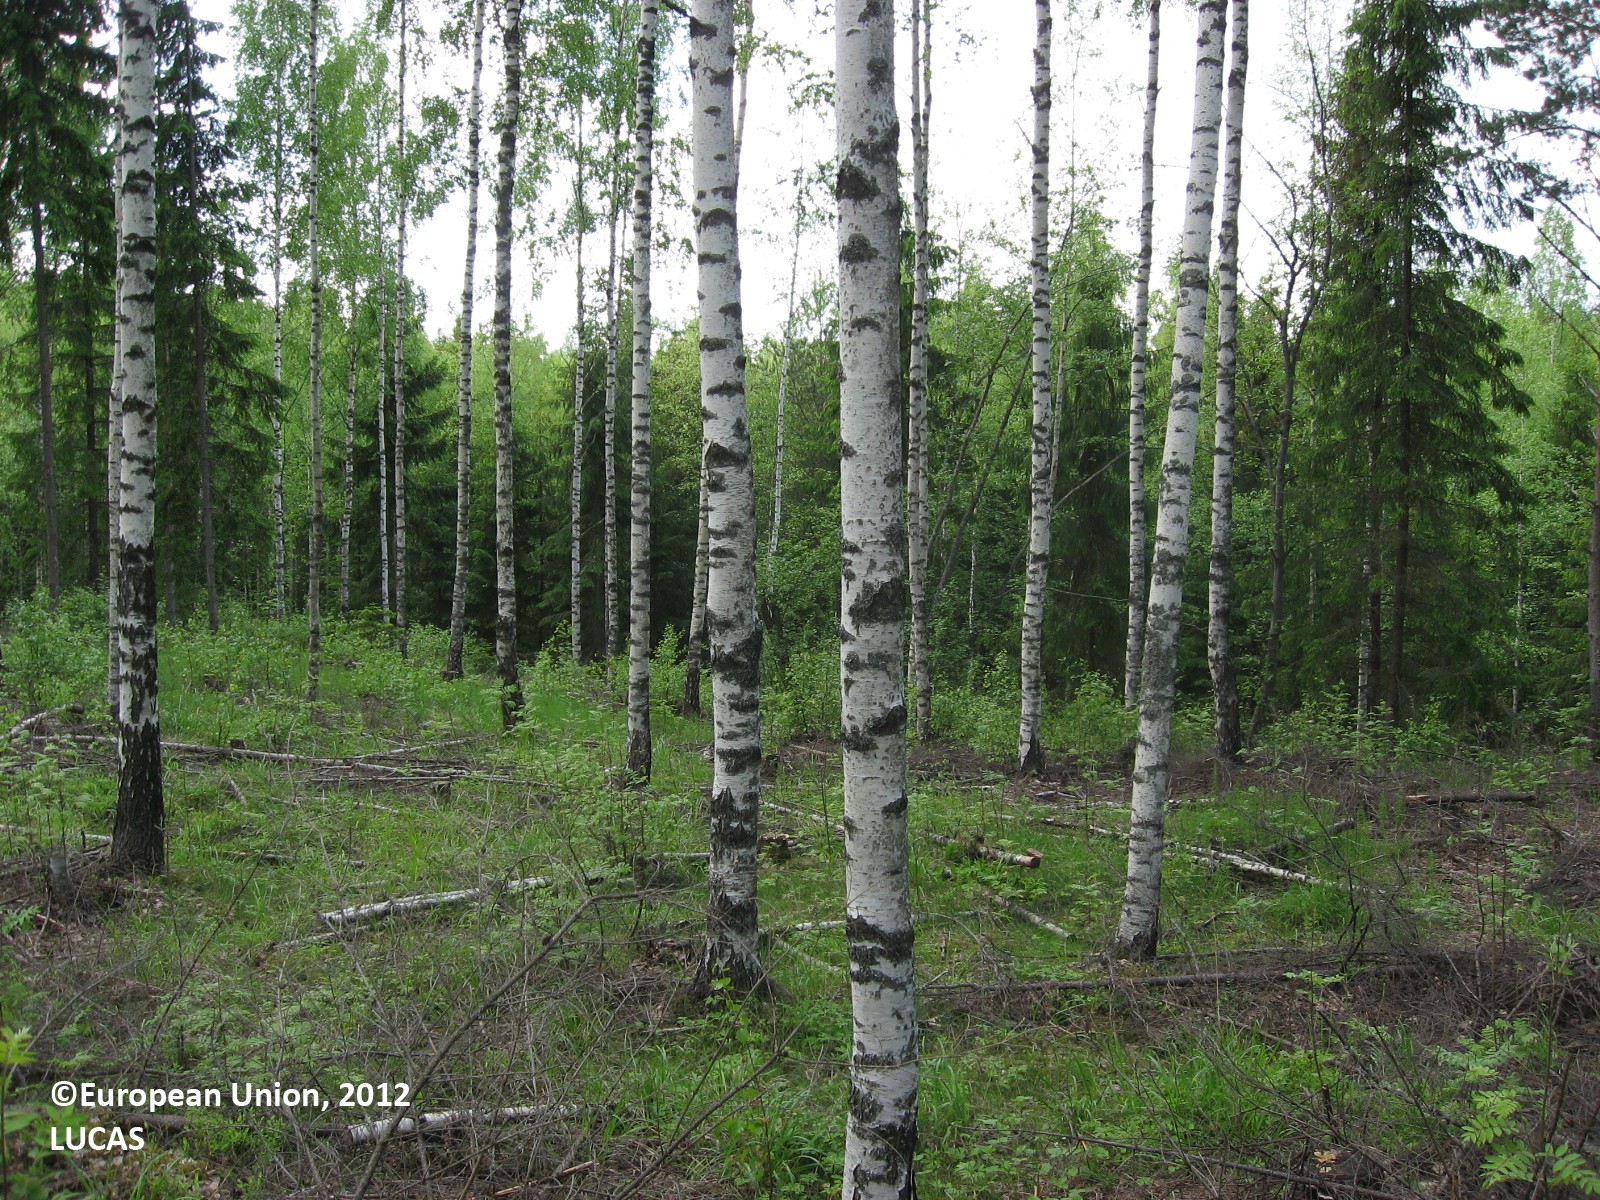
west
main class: Woodland
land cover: Other mixed woodland
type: boreal forest
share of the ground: > 75 %
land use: Forestry
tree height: > 5 m
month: June
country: FI
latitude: 60.4131
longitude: 25.3975
